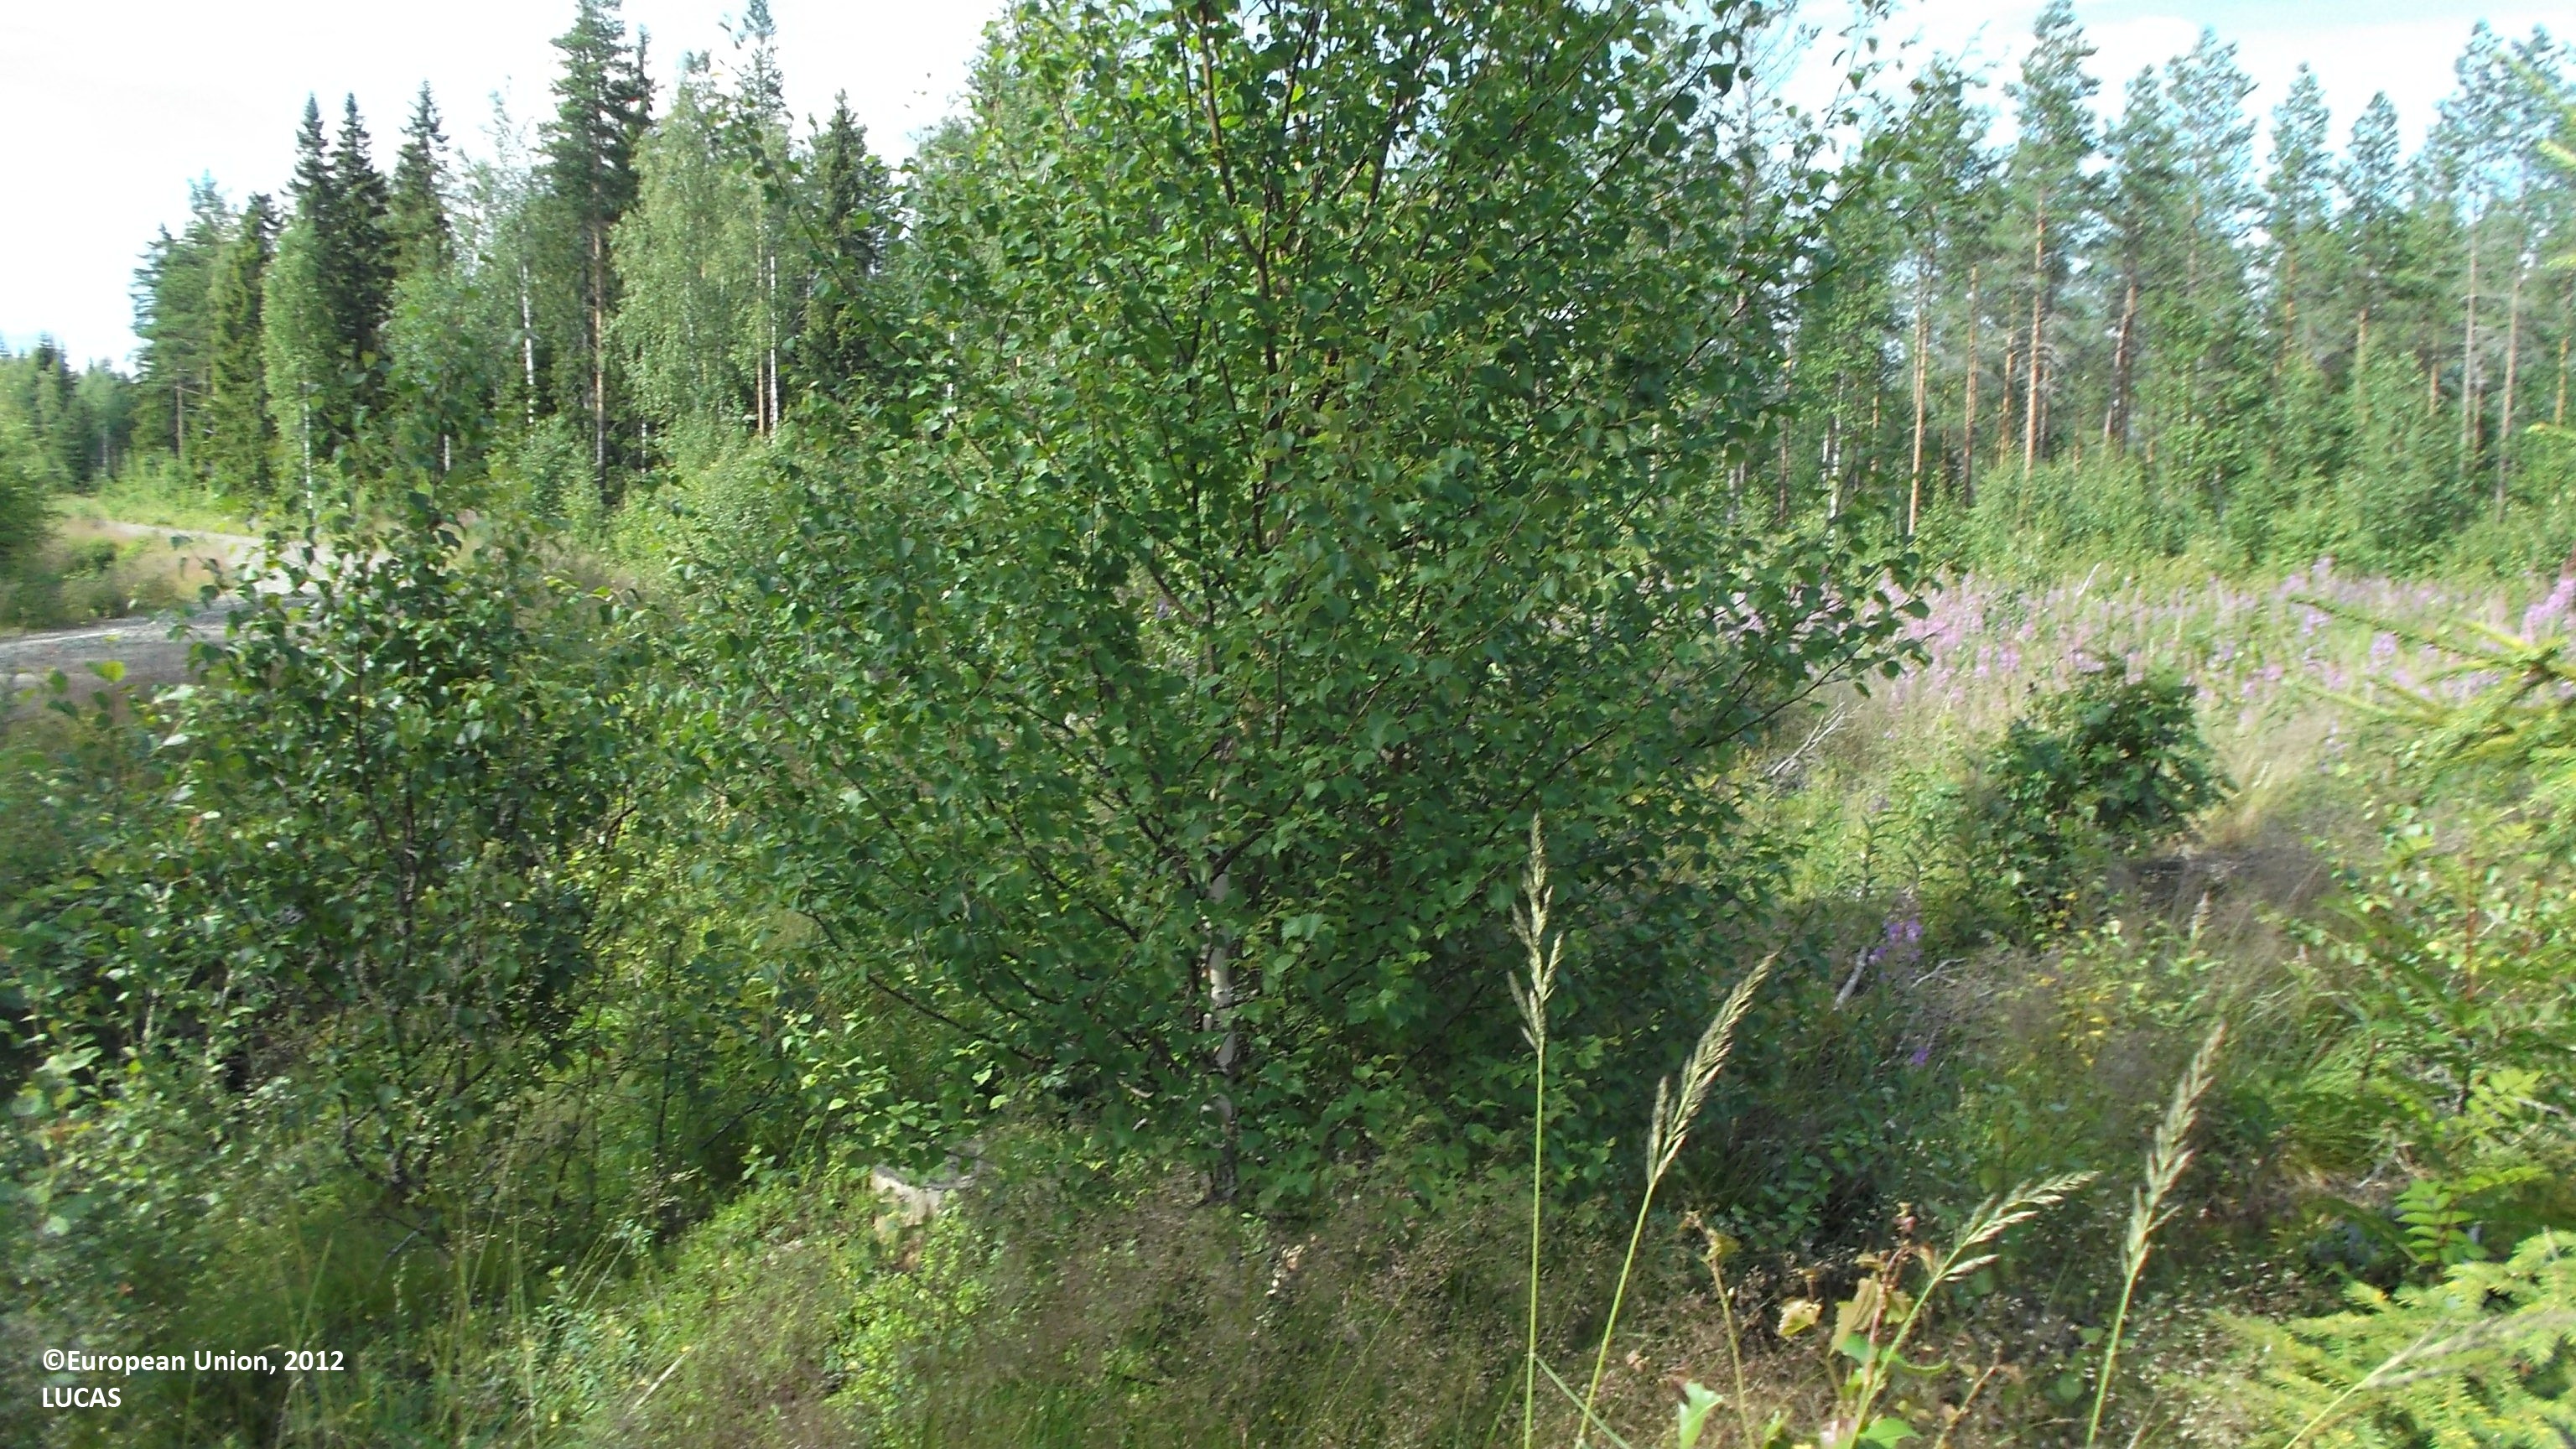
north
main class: Grassland
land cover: Grassland with sparse tree/shrub cover
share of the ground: 25 - 50 %
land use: Forestry
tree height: < 5 m
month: July
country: FI
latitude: 63.2977
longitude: 23.7720
